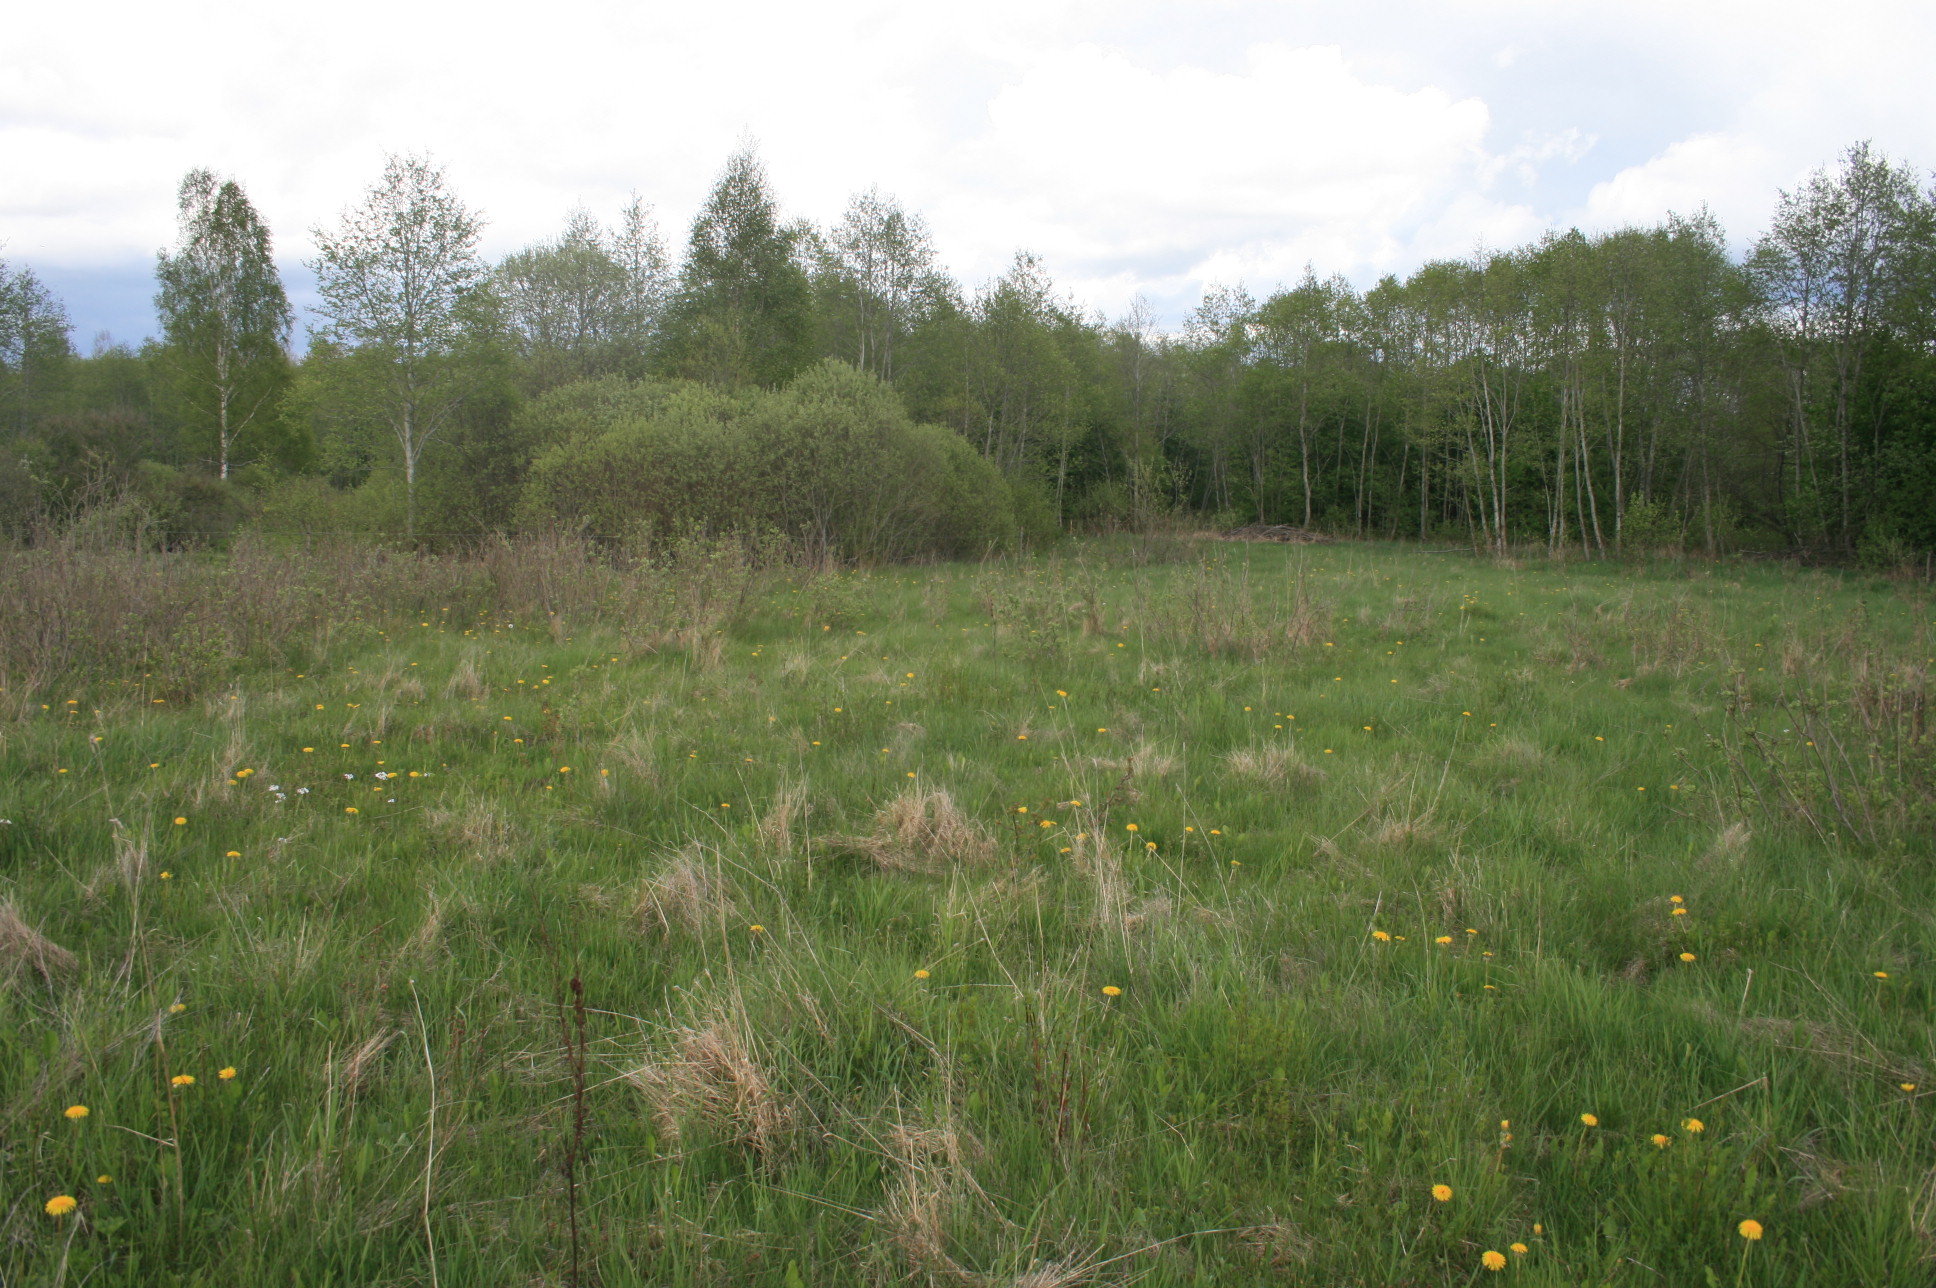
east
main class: Grassland
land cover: Grassland without tree/shrub cover
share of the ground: > 75 %
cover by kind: herbaceous plants 100 %
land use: Agriculture (excluding fallow land and kitchen gardens)
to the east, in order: Grassland without tree/shrub cover; Shrubland without tree cover; Fences; Broadleaved woodland; Spontaneously vegetated surfaces; Broadleaved woodland; Inland fresh running water; Broadleaved woodland; Grassland without tree/shrub cover
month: May
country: LT
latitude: 56.1783
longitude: 22.0855
